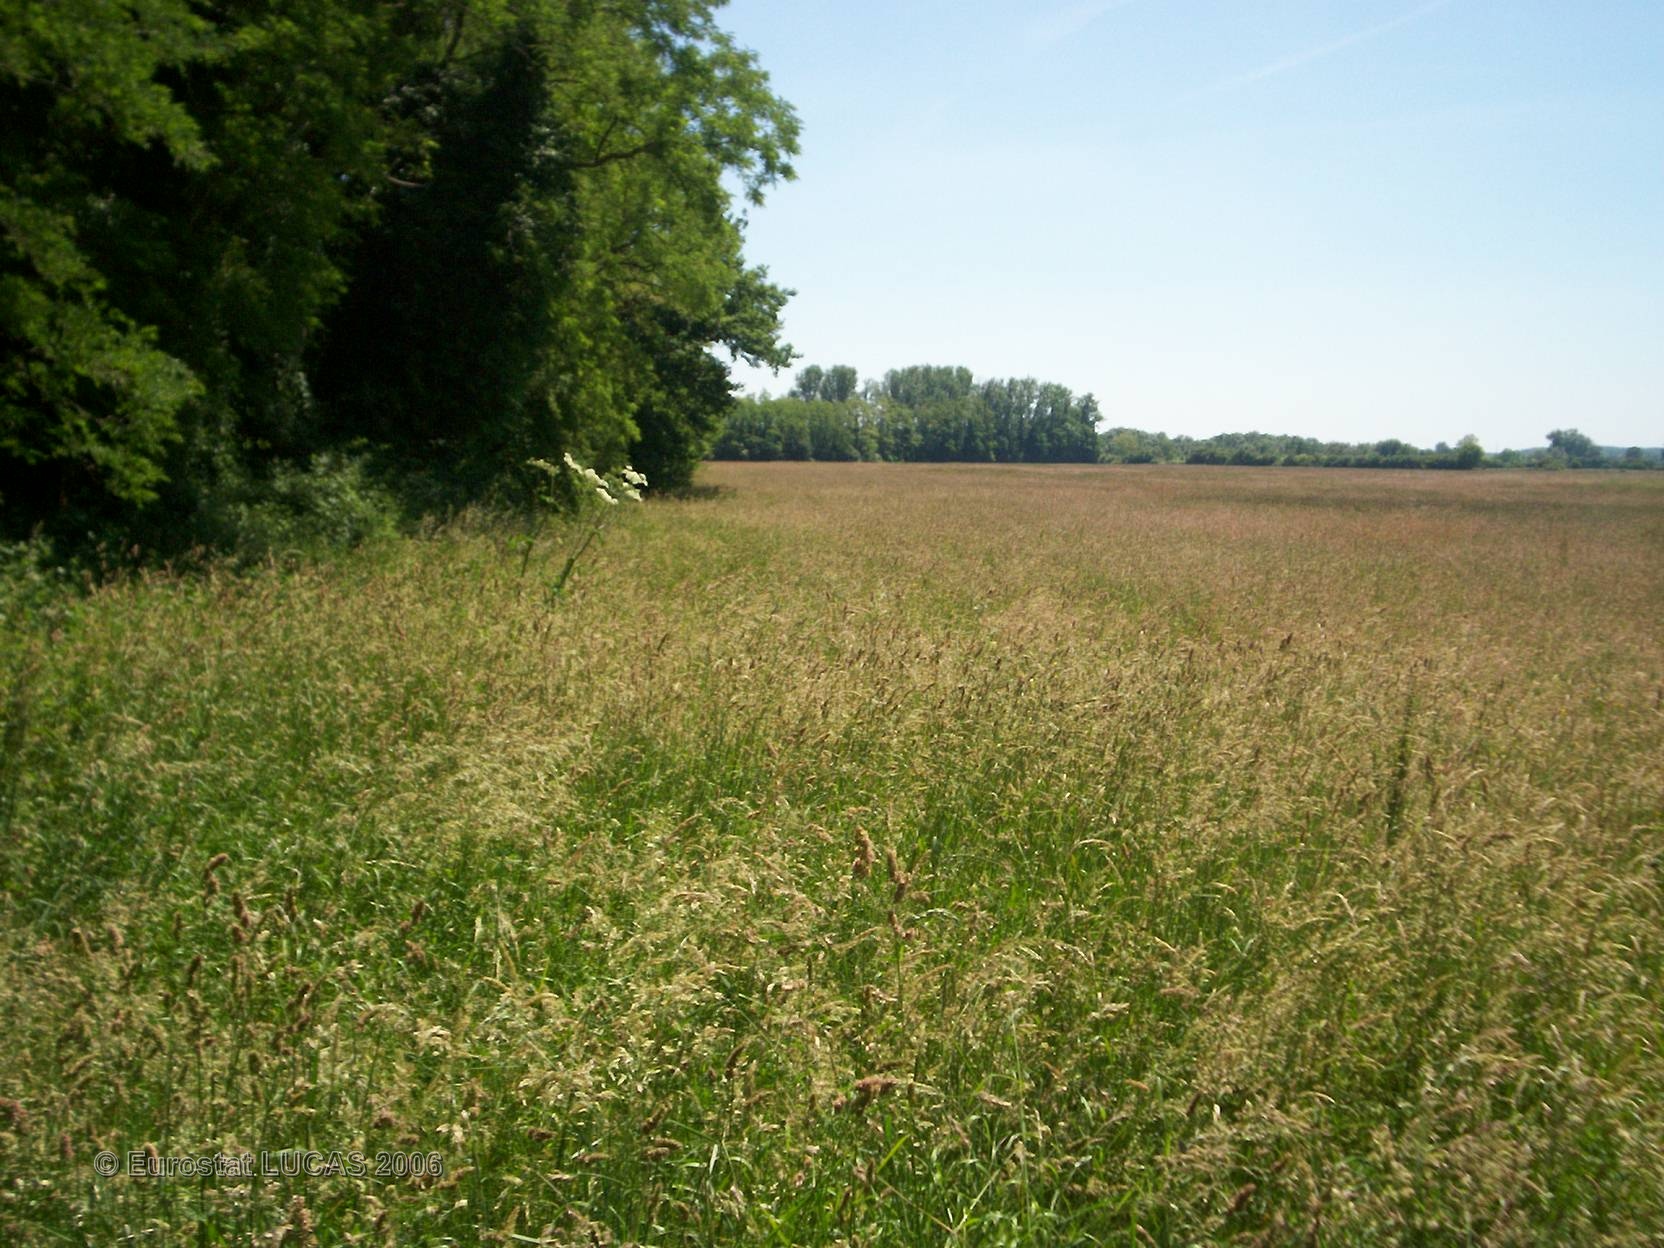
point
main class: Grassland
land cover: Grassland without tree/shrub cover
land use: Agriculture (excluding fallow land and kitchen gardens)
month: June
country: FR
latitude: 47.0115
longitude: 3.0638
